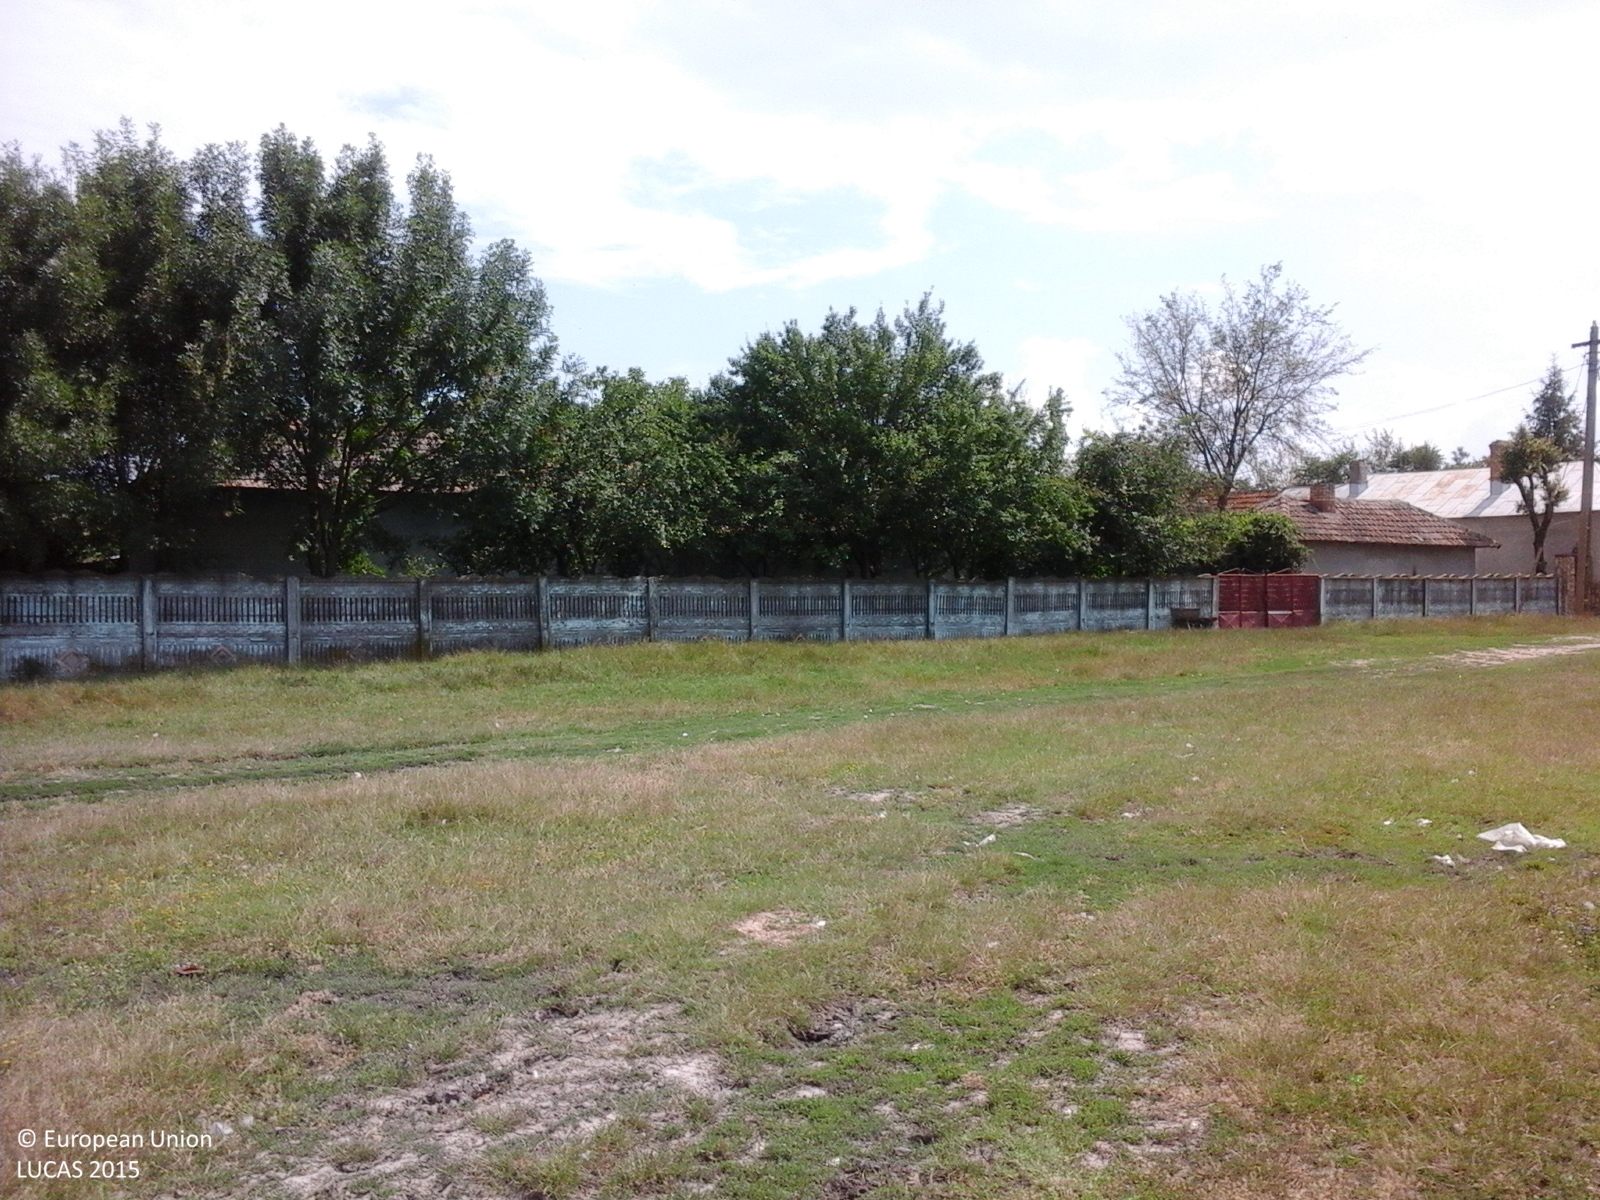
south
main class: Grassland
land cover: Grassland without tree/shrub cover
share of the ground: > 75 %
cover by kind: herbaceous plants 100 %
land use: Agriculture (excluding fallow land and kitchen gardens)
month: July
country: RO
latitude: 44.0412
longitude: 25.2443
